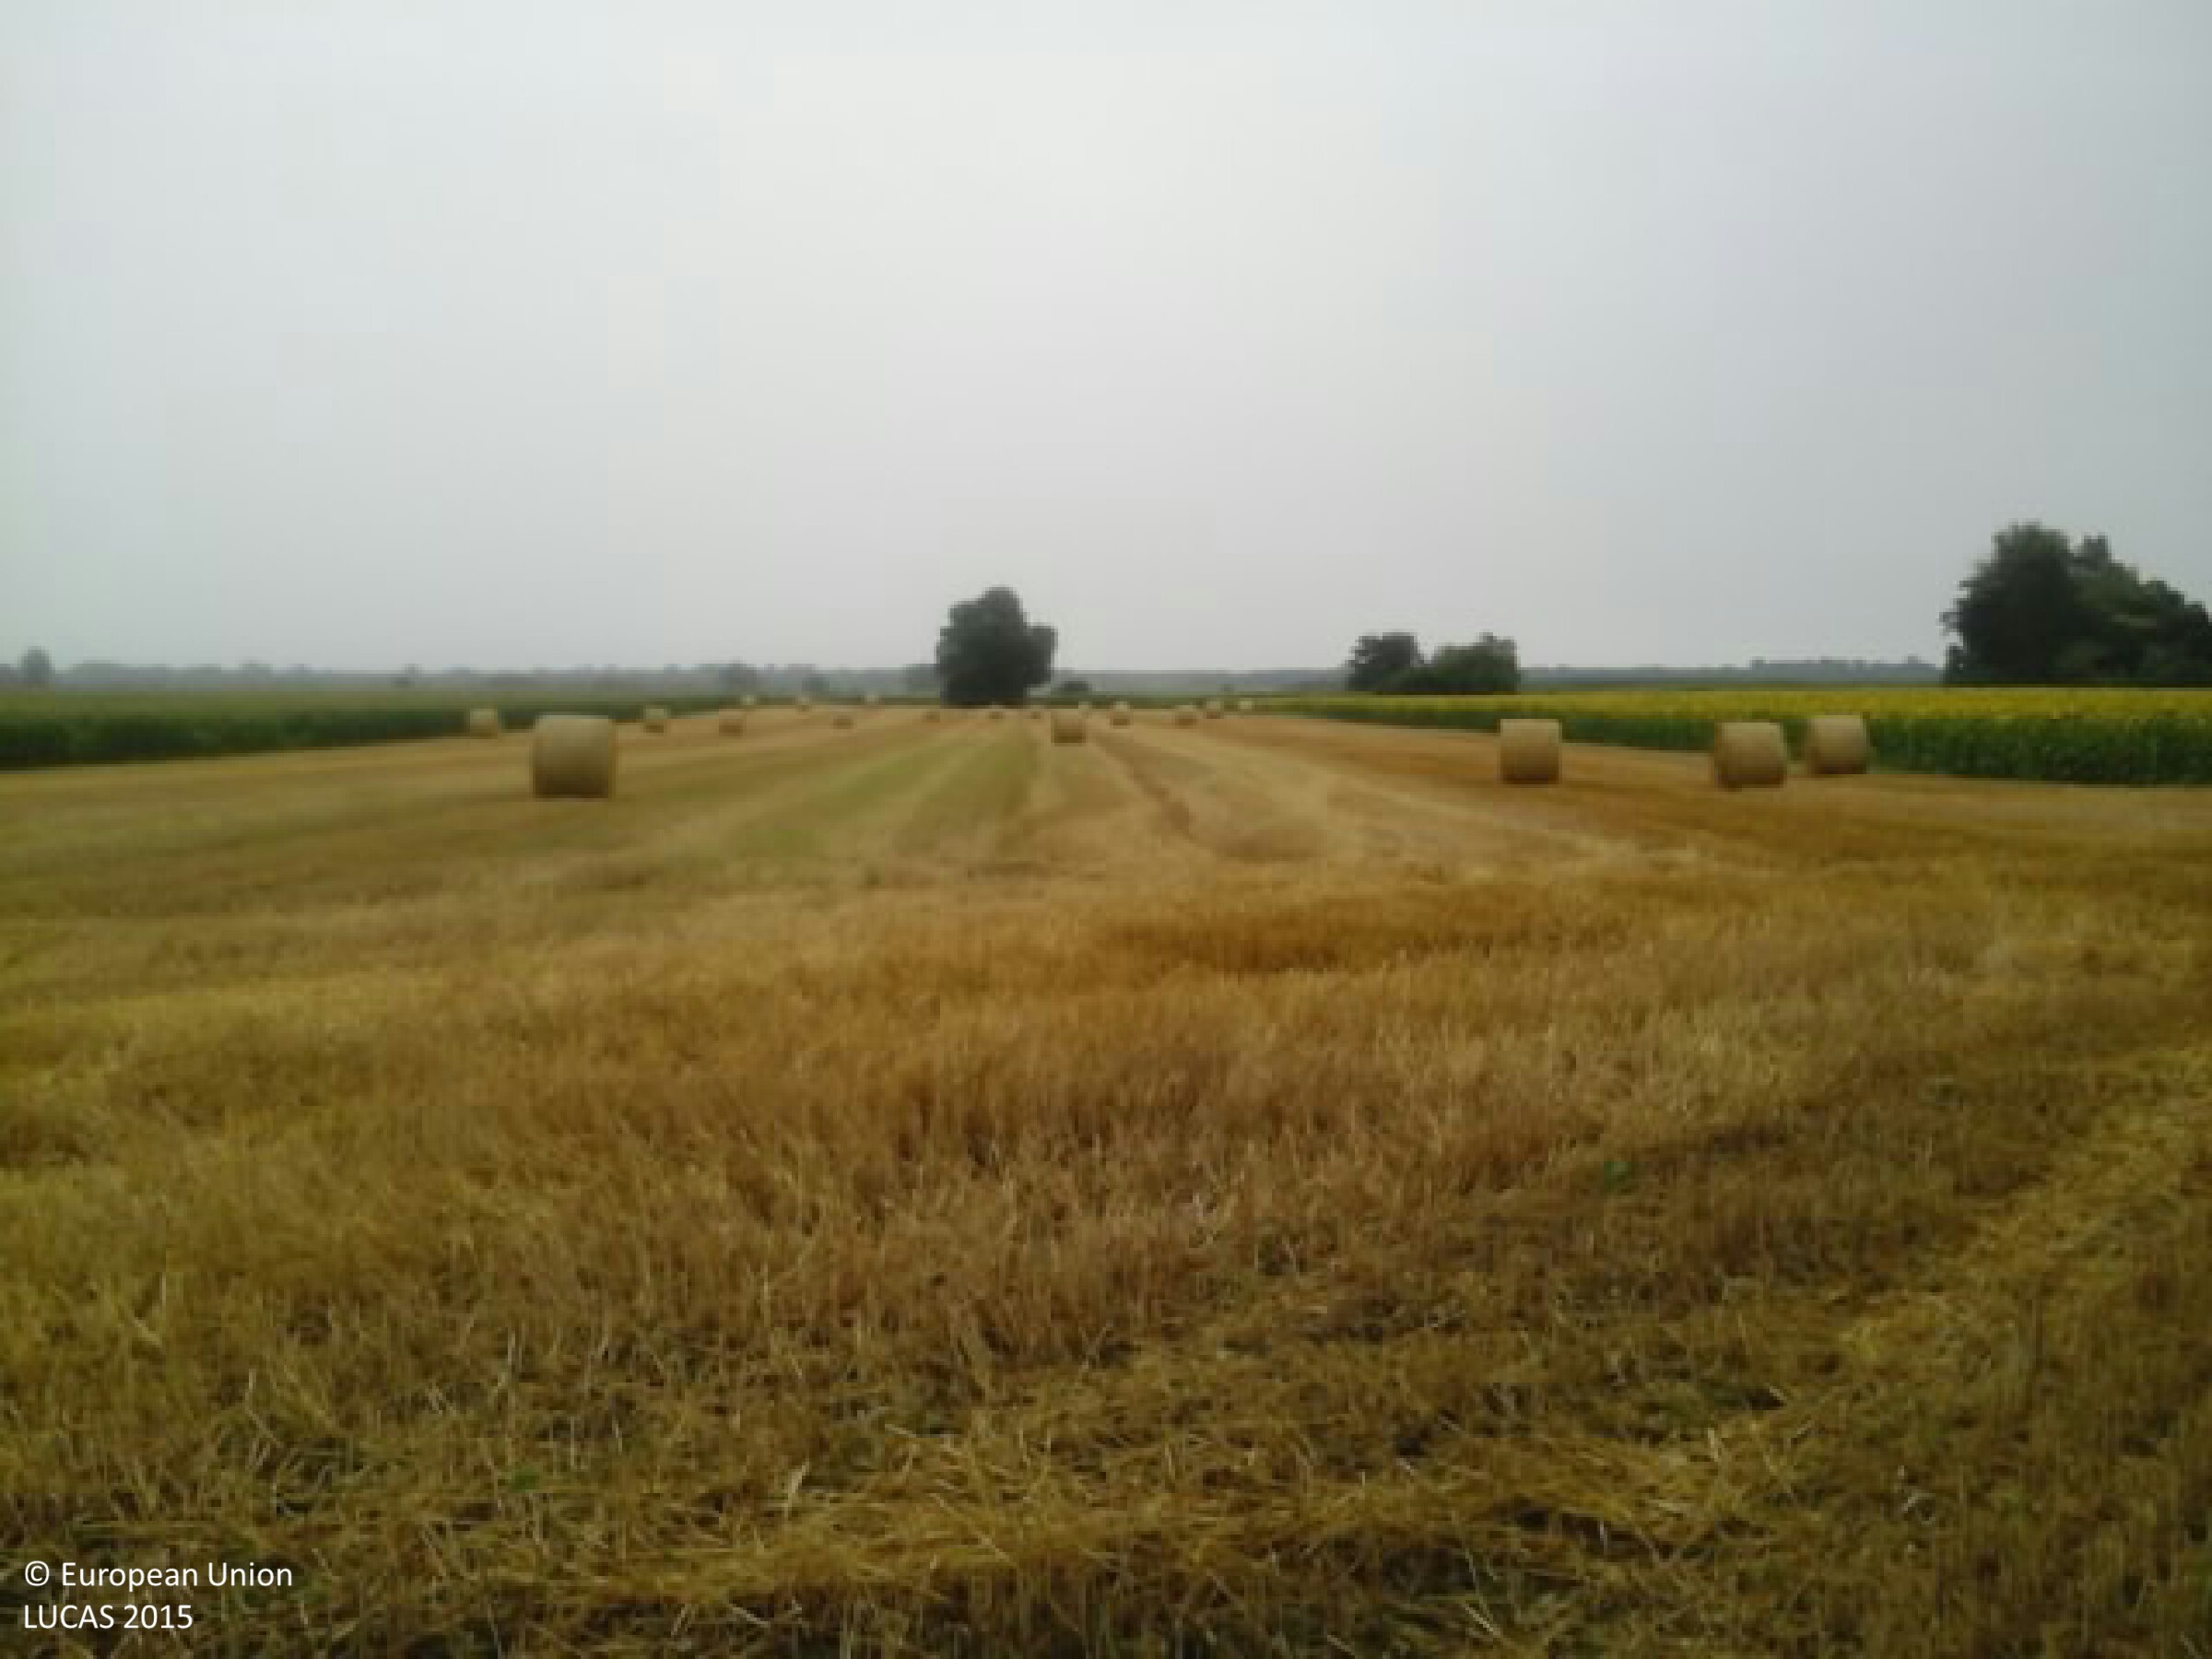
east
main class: Cropland
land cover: Rye
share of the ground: 50 - 75 %
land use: Agriculture (excluding fallow land and kitchen gardens)
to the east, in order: Rye; Sunflower
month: July
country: HU
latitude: 46.3452
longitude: 18.8606
